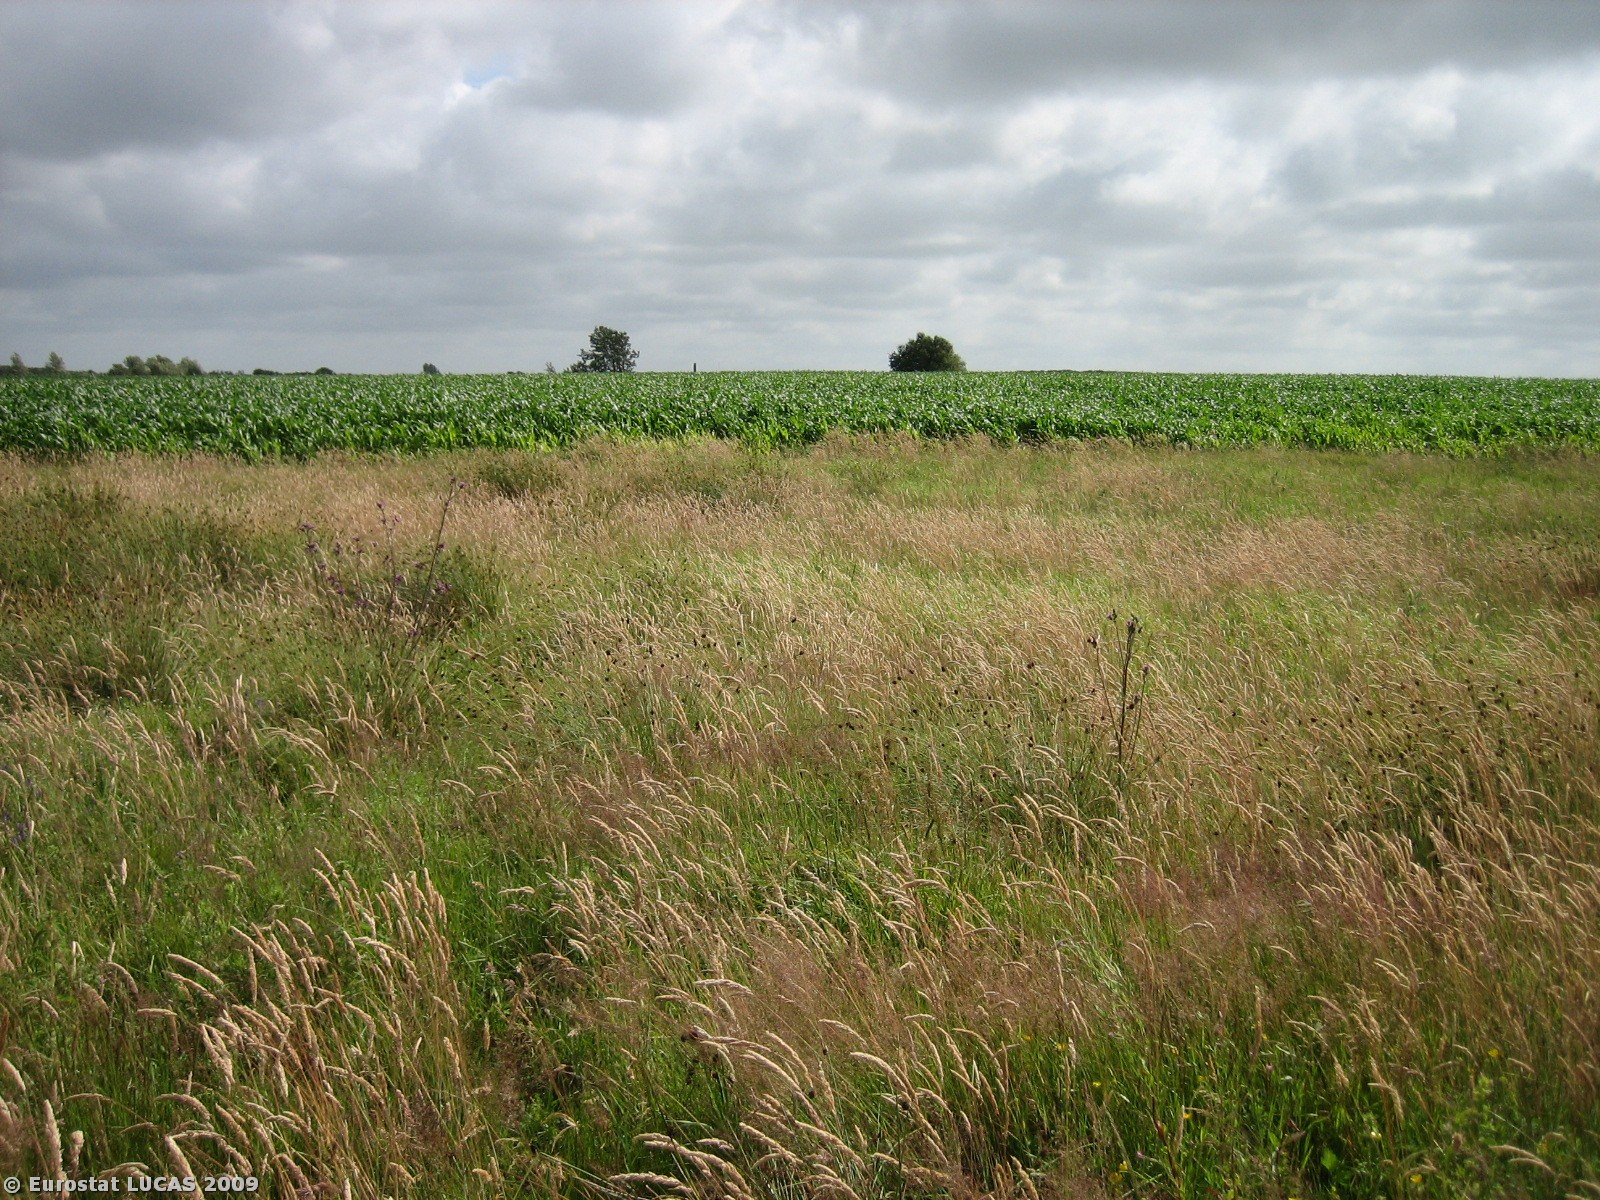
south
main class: Grassland
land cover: Grassland without tree/shrub cover
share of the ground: > 75 %
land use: Unused
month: July
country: DK
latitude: 55.6747
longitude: 8.4272
